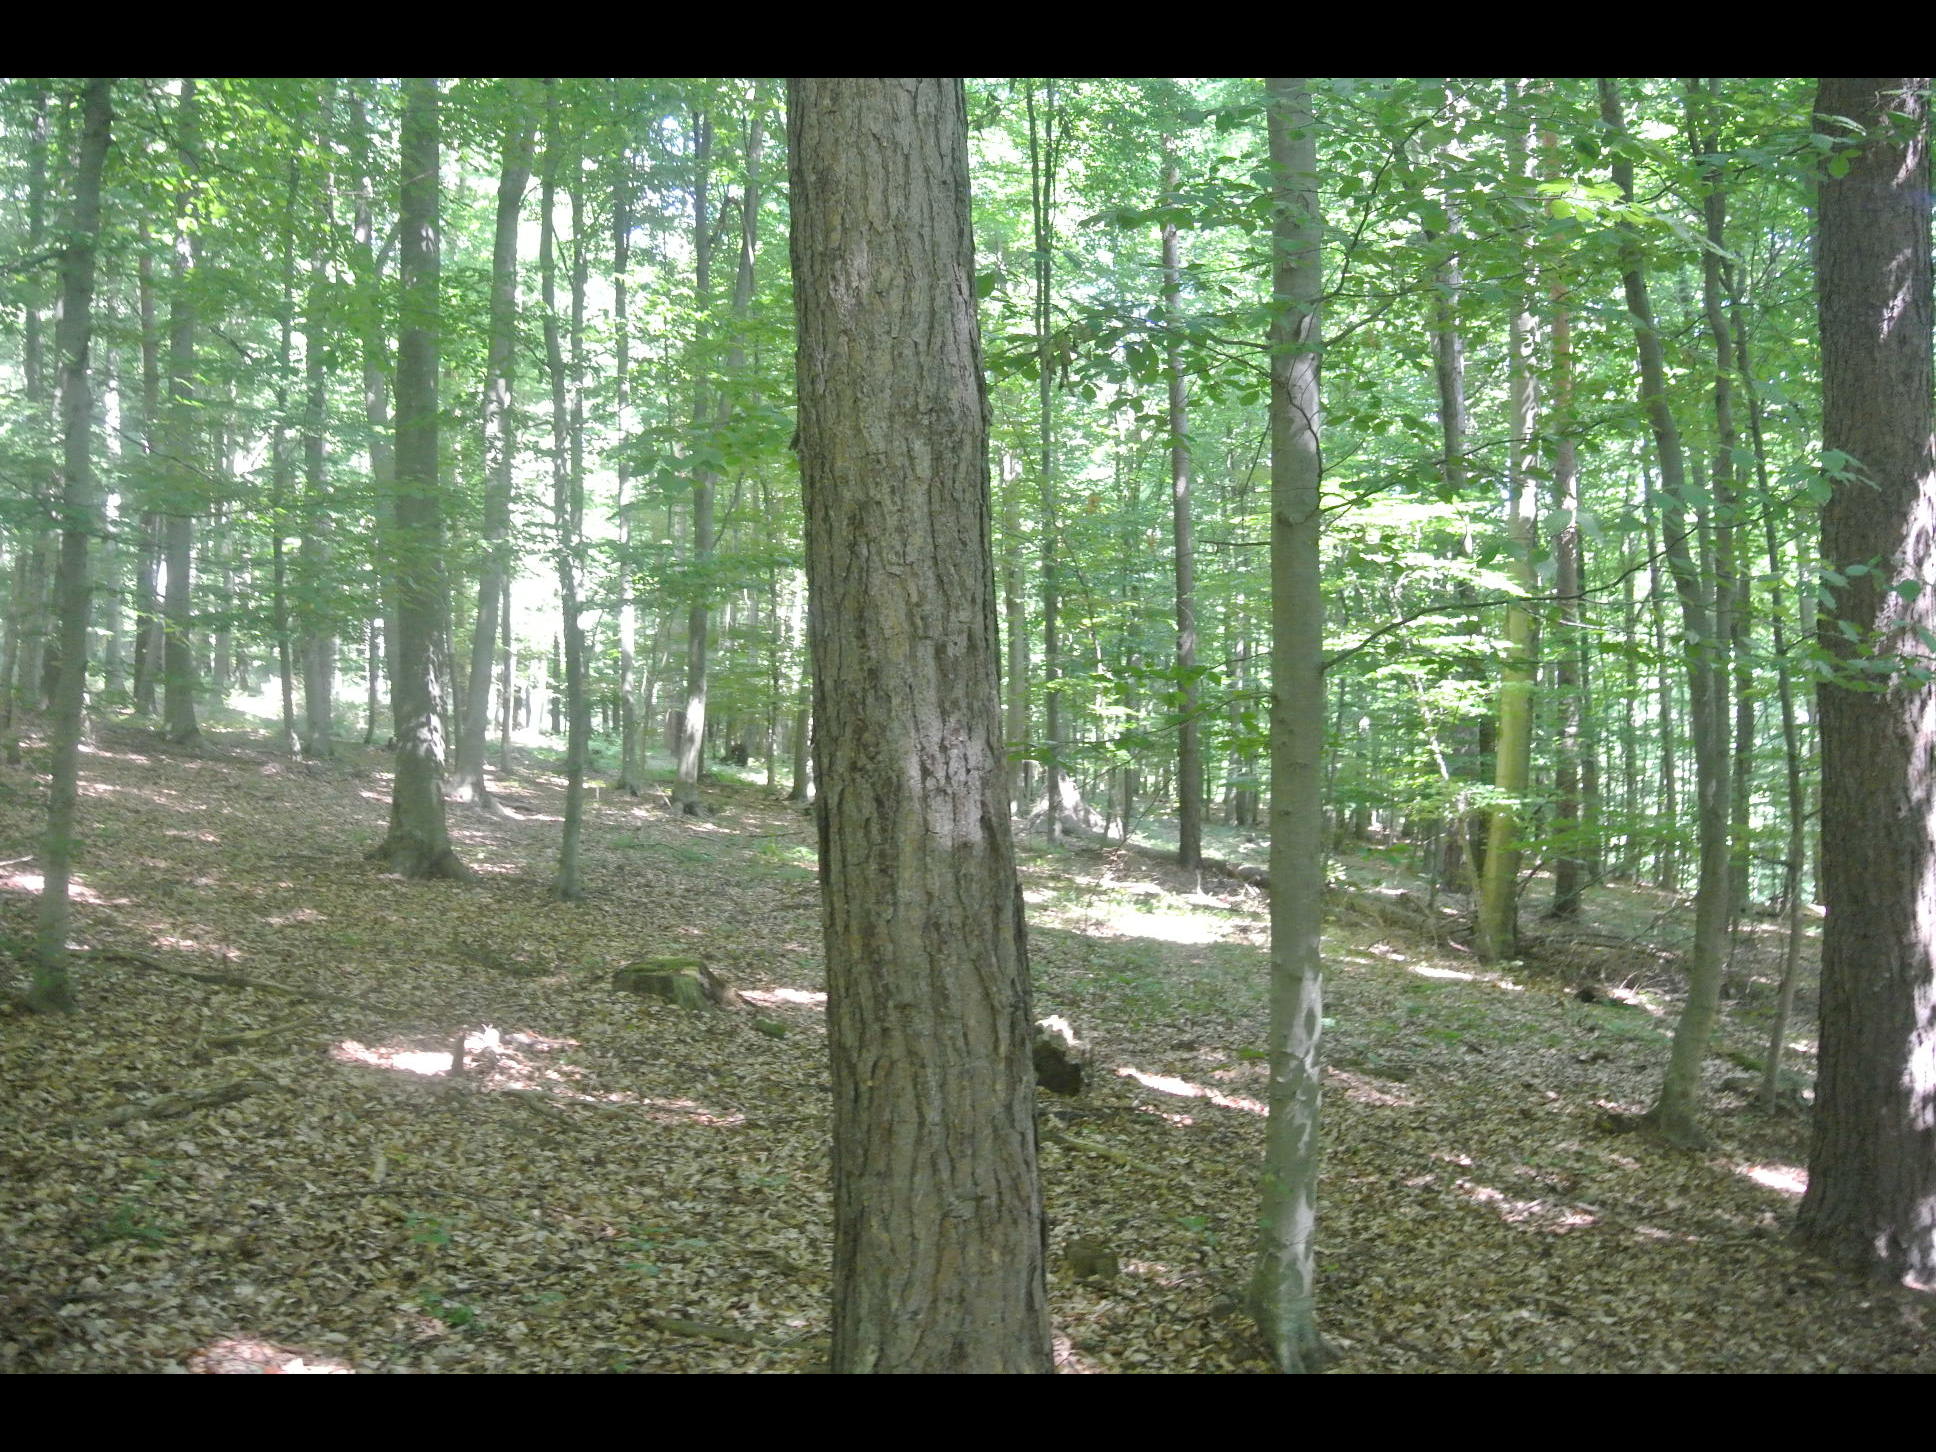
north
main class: Woodland
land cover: Broadleaved woodland
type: beech forest
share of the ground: > 75 %
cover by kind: broadleaved forest trees 100 %
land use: Forestry
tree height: > 5 m
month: July
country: AT
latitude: 47.6369
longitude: 16.4592
